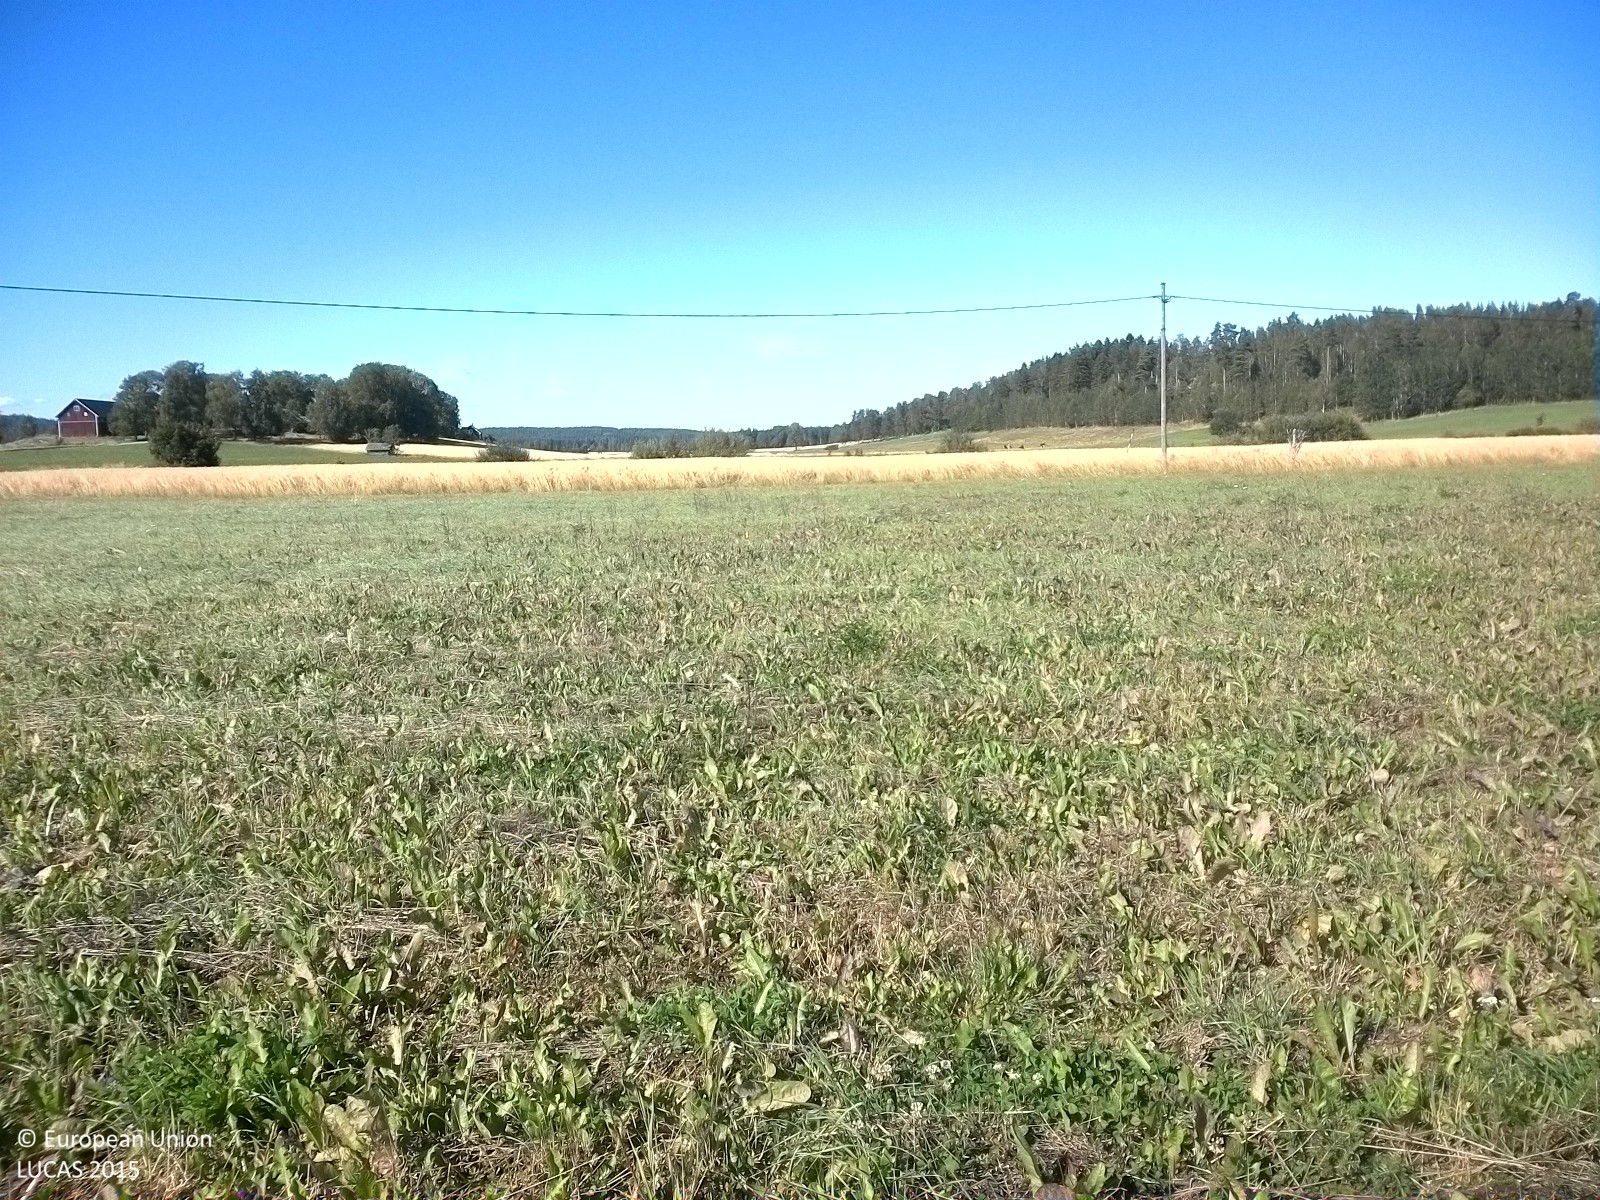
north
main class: Grassland
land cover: Grassland without tree/shrub cover
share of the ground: > 75 %
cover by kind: herbaceous plants 100 %
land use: Agriculture (excluding fallow land and kitchen gardens)
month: August
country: SE
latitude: 59.3845
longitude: 15.1141
